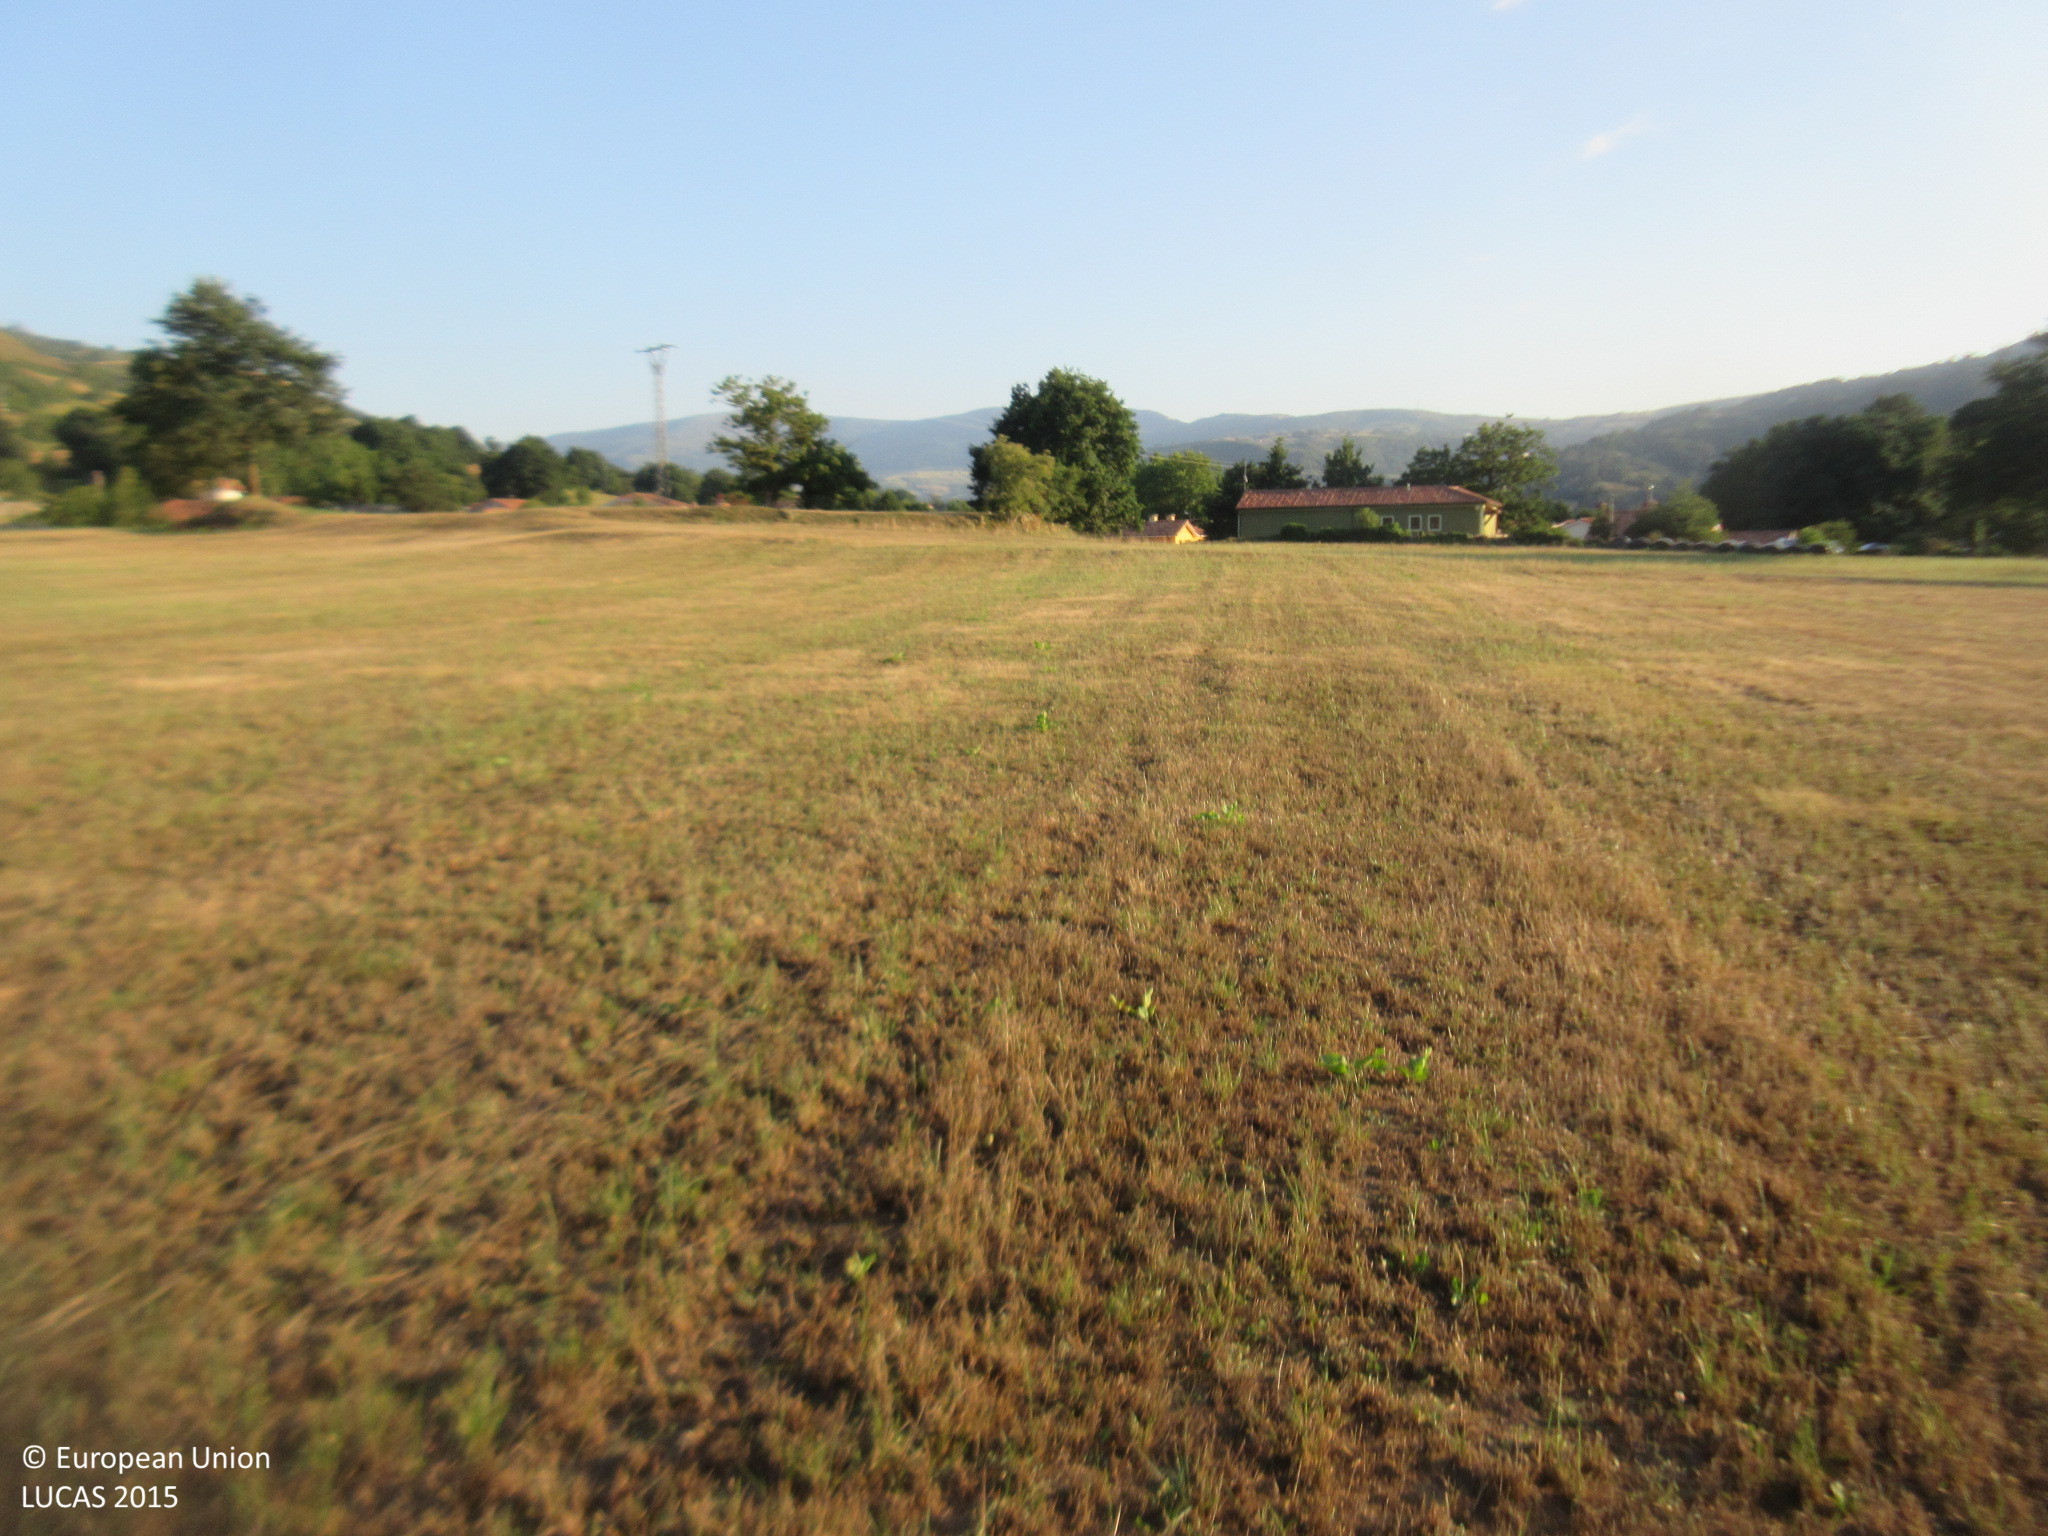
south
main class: Cropland
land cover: Temporary grasslands
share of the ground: > 75 %
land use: Agriculture (excluding fallow land and kitchen gardens)
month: July
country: ES
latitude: 43.2591
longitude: -3.9324
